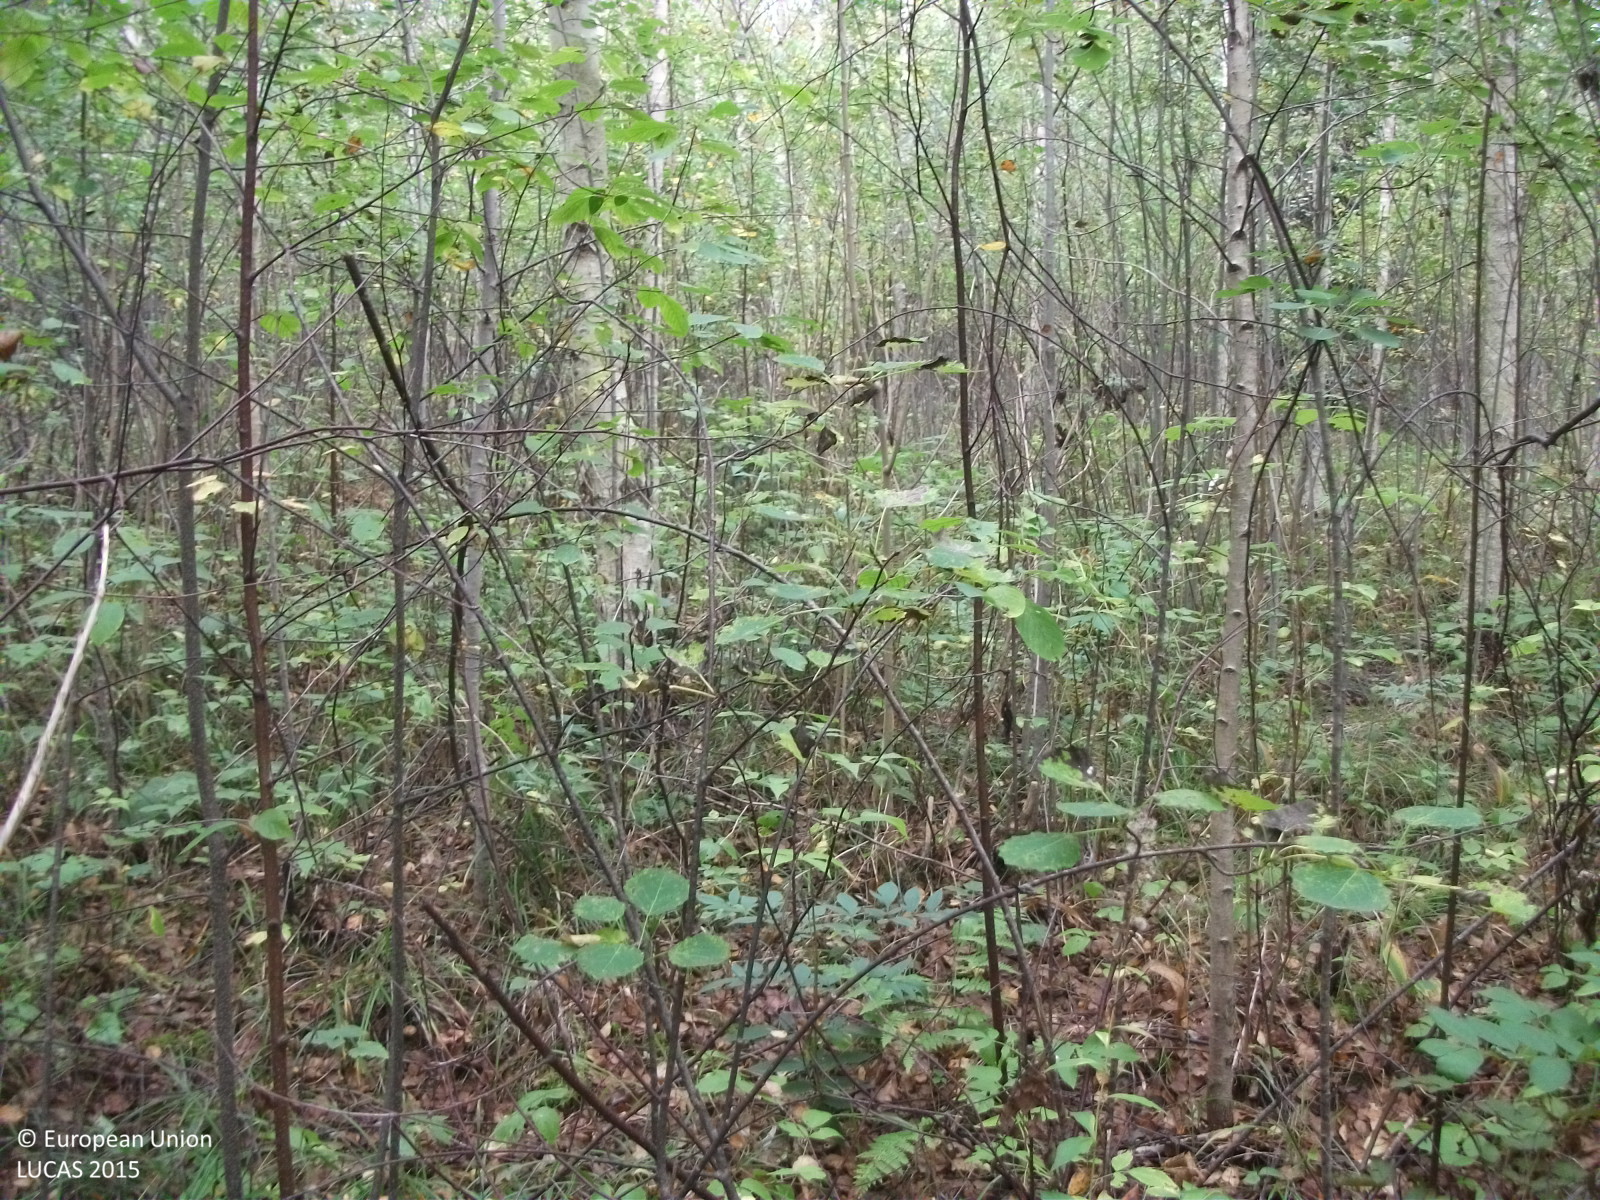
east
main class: Woodland
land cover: Broadleaved woodland
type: non-riverine alder, birch or aspen forest
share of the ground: > 75 %
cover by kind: broadleaved forest trees 90 %, shrubs 5 %, herbaceous plants 5 %
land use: Forestry
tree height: > 5 m
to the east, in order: Broadleaved woodland; Spruce dominated coniferous woodland; Other mixed woodland; Spontaneously vegetated surfaces; Ditches and canals; Broadleaved woodland
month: September
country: LV
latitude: 57.8074
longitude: 24.3743
